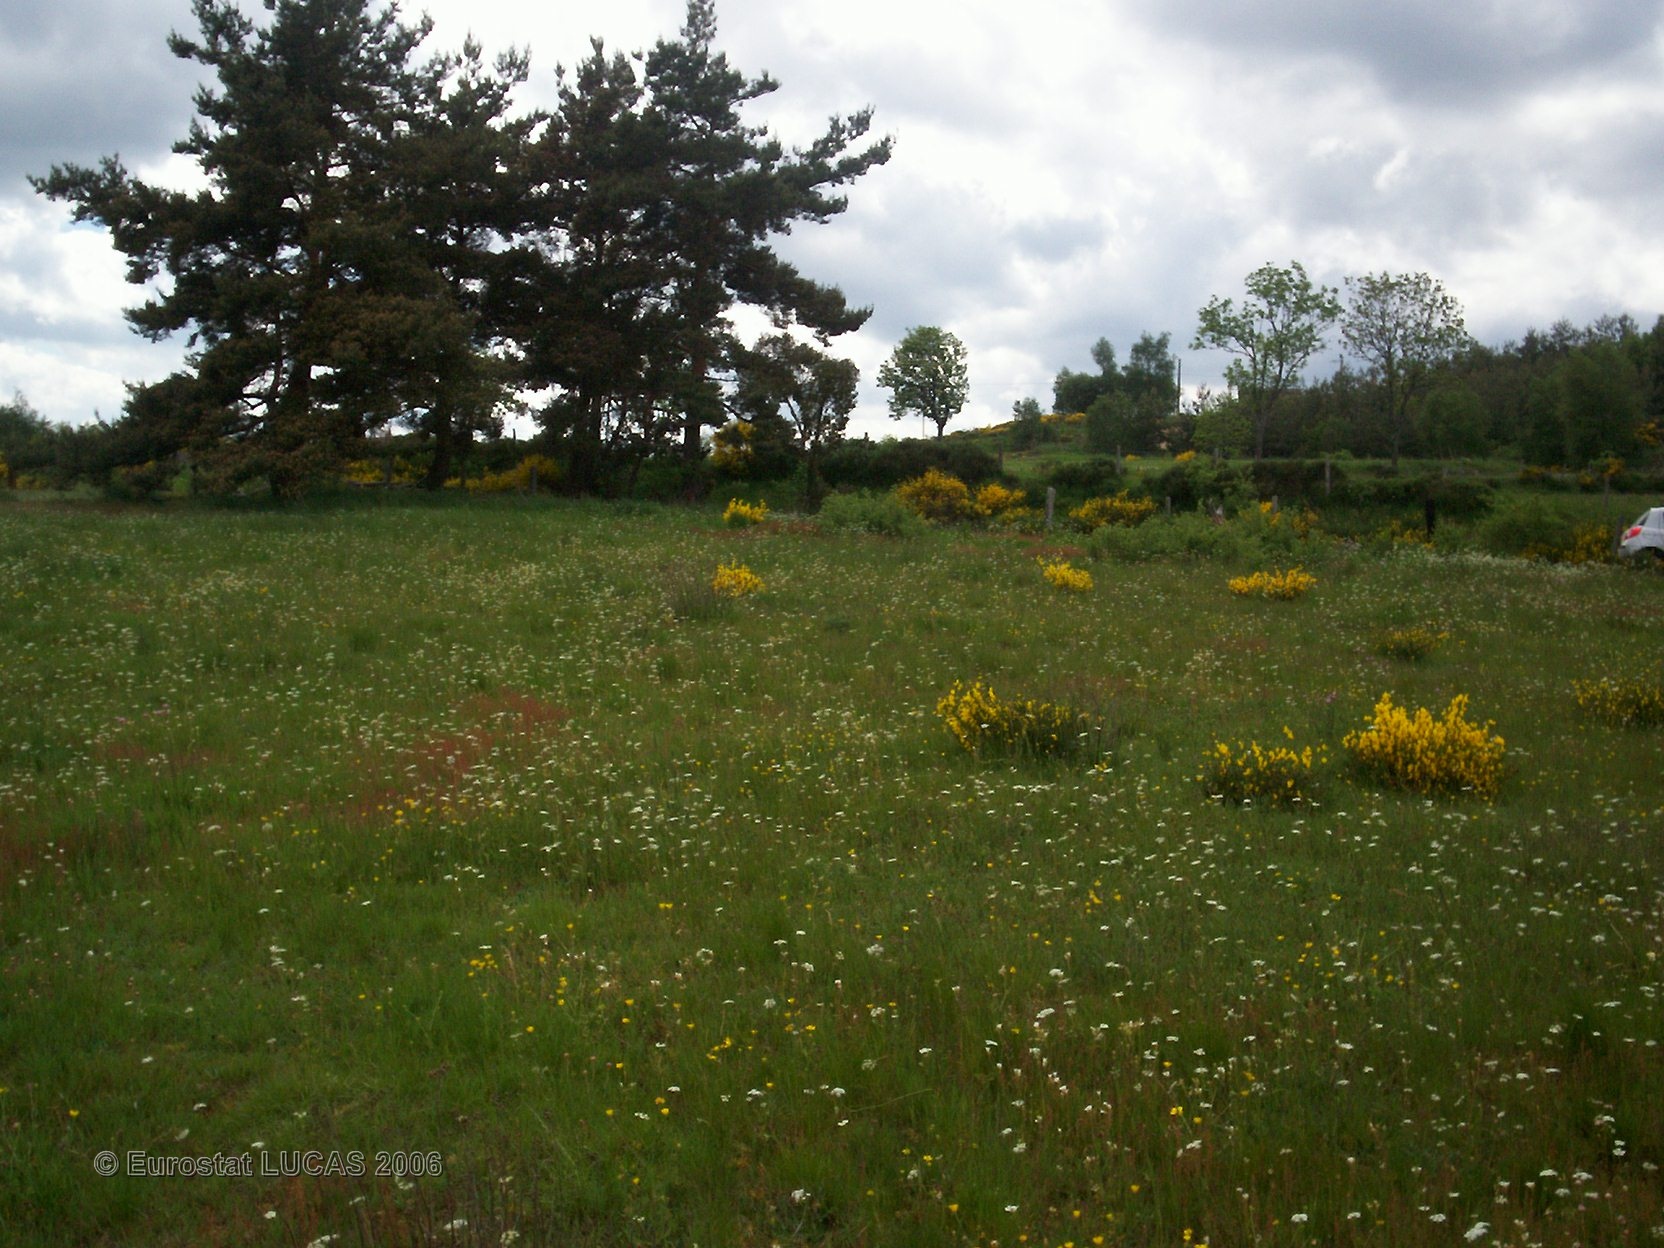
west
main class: Grassland
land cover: Grassland without tree/shrub cover
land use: Agriculture (excluding fallow land and kitchen gardens)
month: May
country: FR
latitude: 44.7911
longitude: 3.3932
